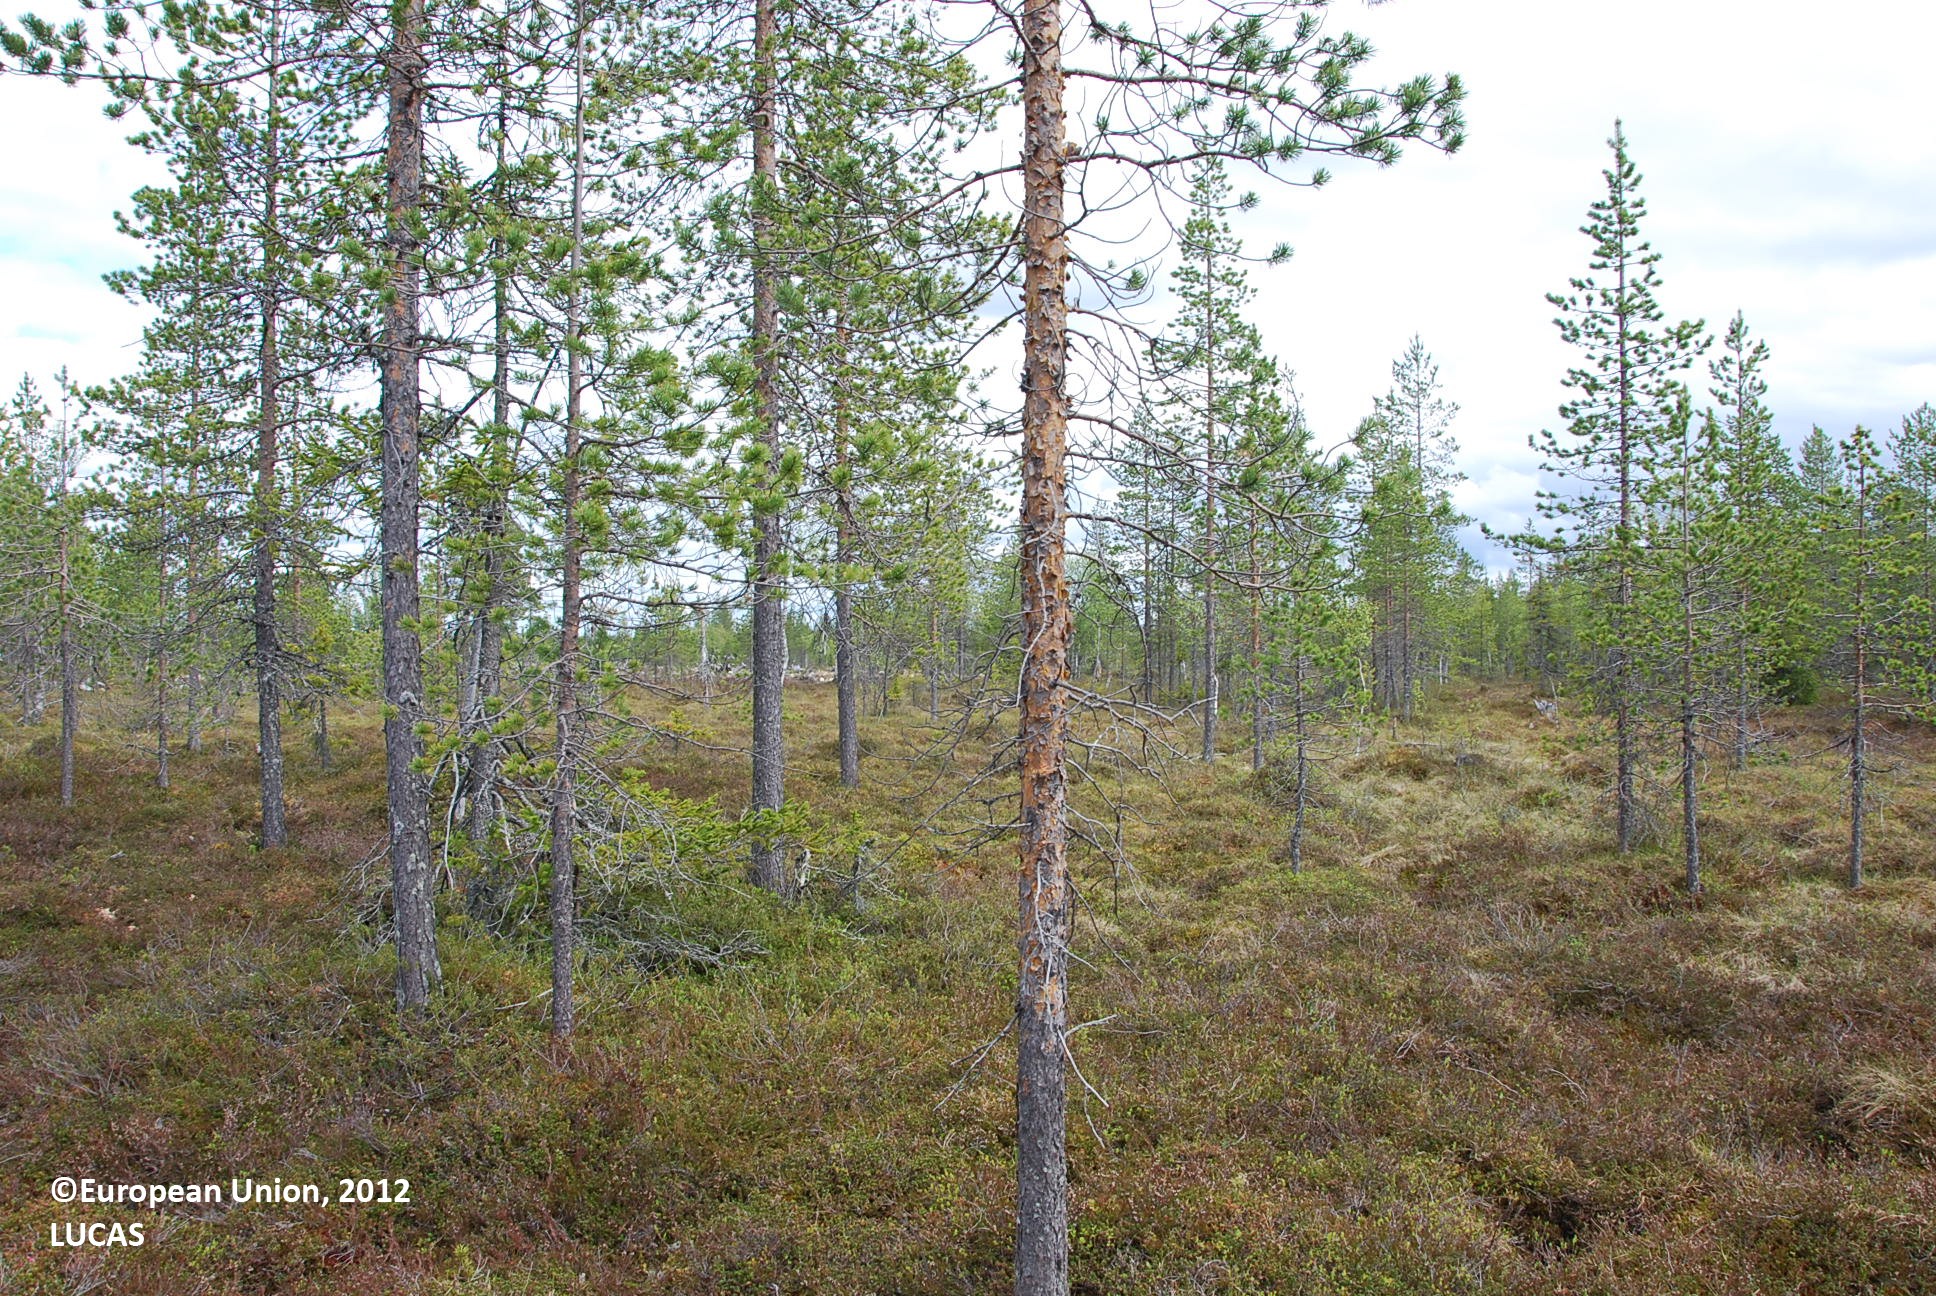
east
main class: Woodland
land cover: Pine dominated mixed woodland
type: boreal forest
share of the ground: 25 - 50 %
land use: Forestry
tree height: > 5 m
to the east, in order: Pine dominated mixed woodland
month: June
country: FI
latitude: 66.1842
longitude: 27.7253
